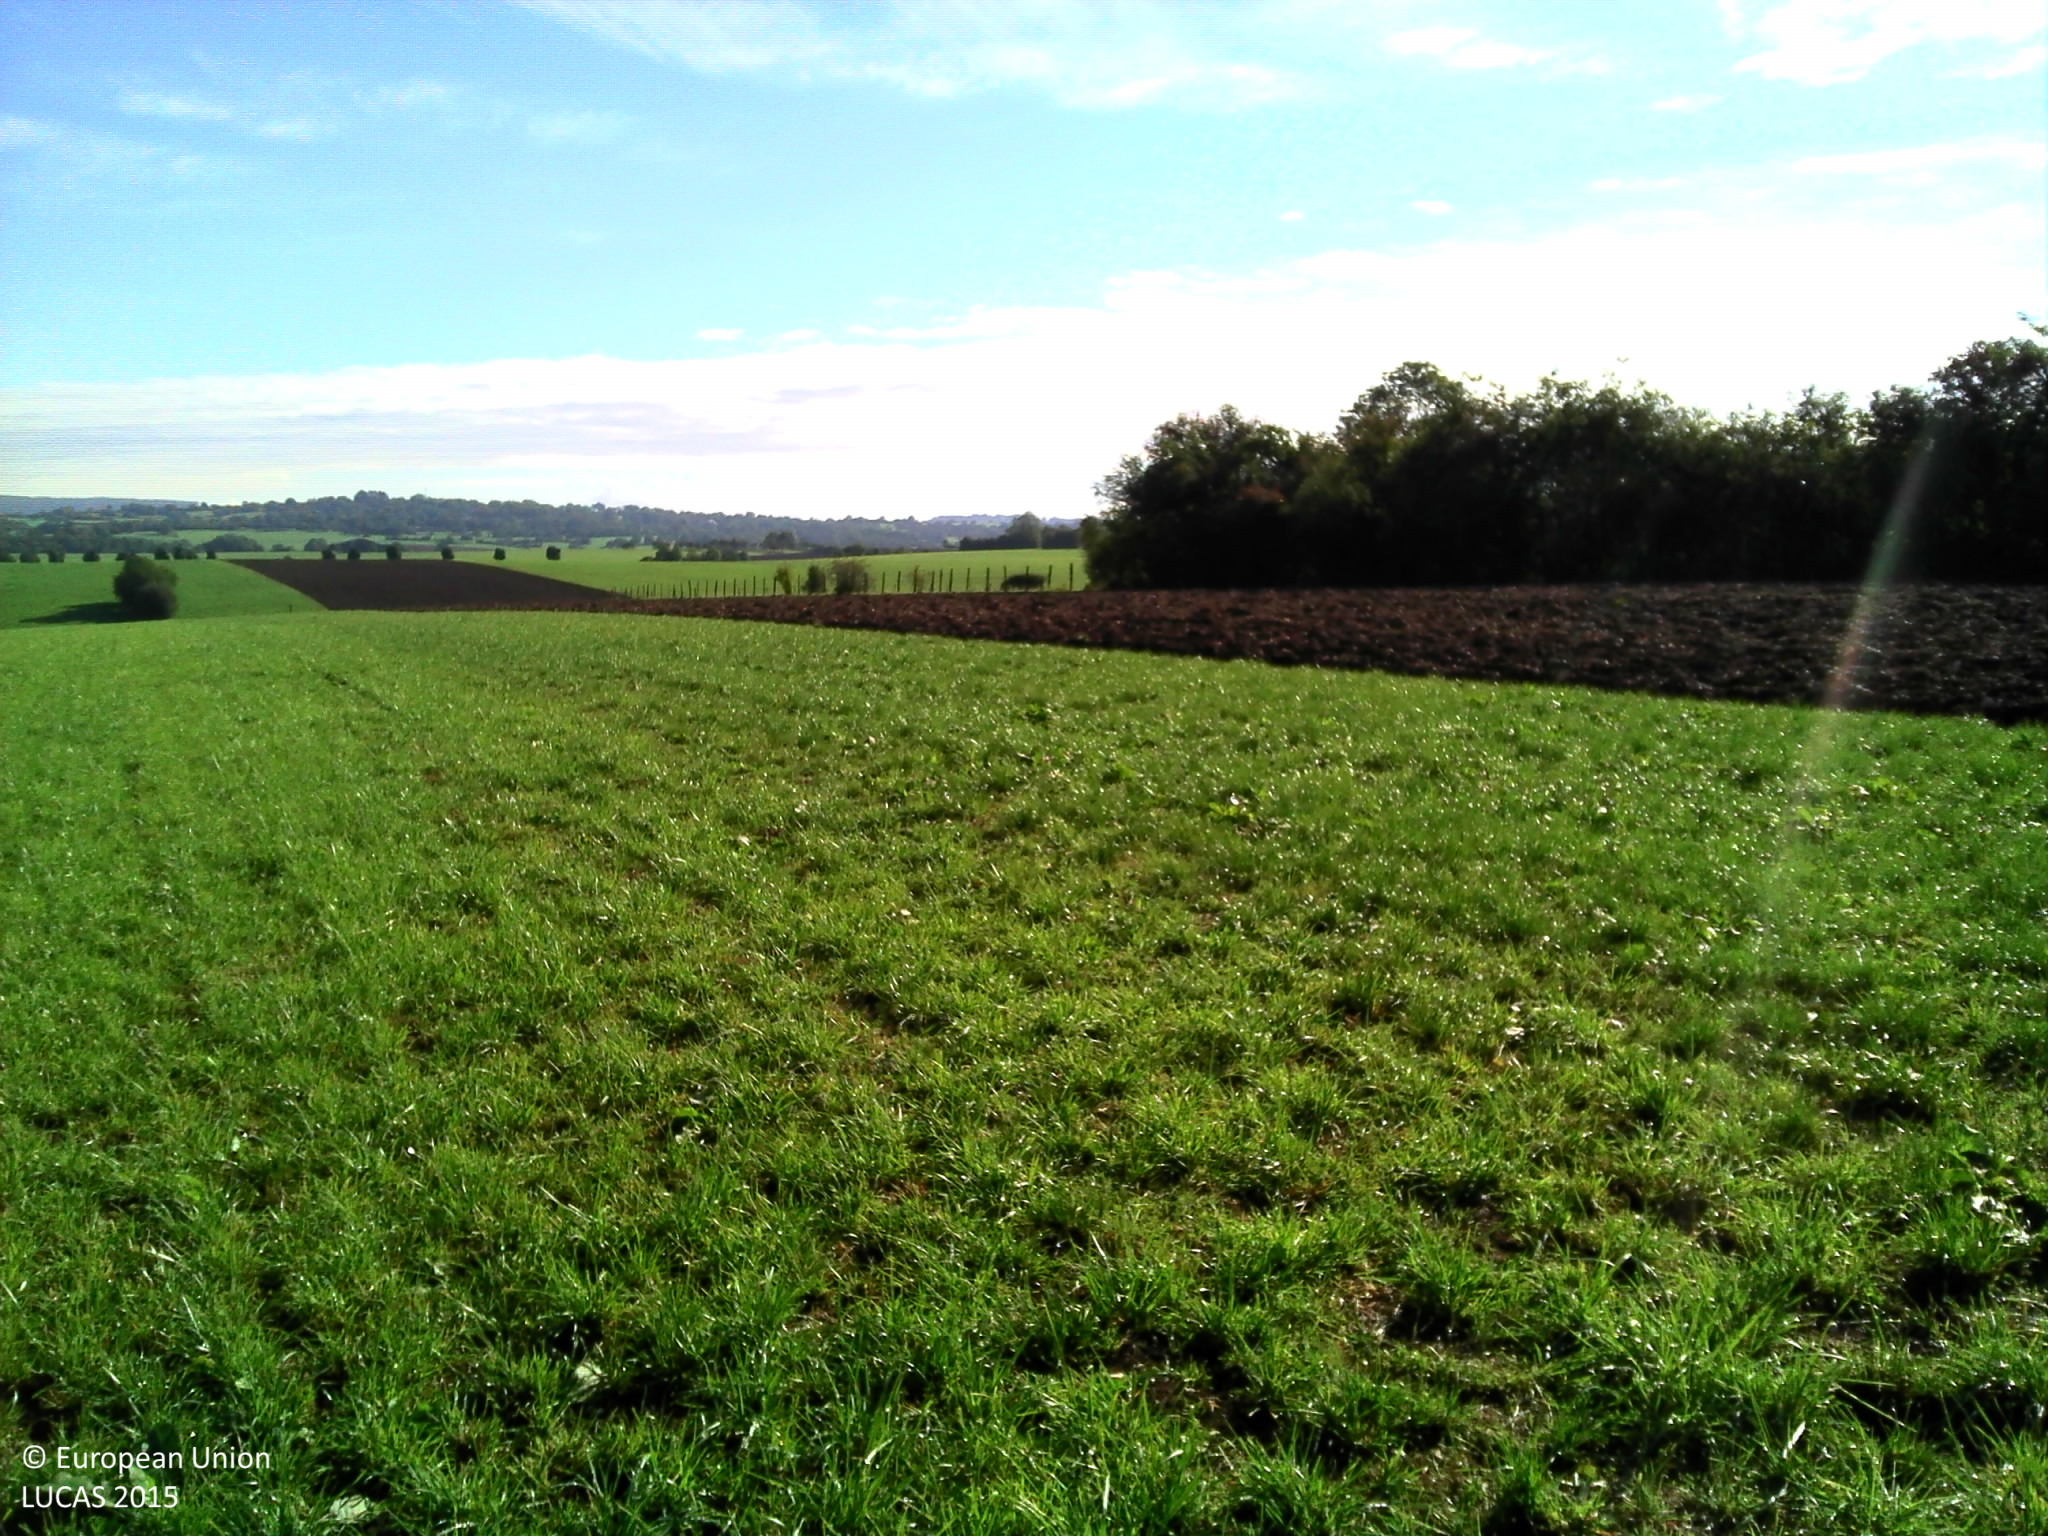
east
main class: Grassland
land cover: Grassland without tree/shrub cover
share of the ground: > 75 %
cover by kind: herbaceous plants 100 %
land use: Agriculture (excluding fallow land and kitchen gardens)
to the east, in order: Grassland without tree/shrub cover; Other bare soil; Fences; Managed hedges; Grassland without tree/shrub cover; Managed hedges; Fences; Tracks; Grass margins; Other bare soil; Grassland without tree/shrub cover
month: September
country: FR
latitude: 47.1164
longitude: 6.2986
